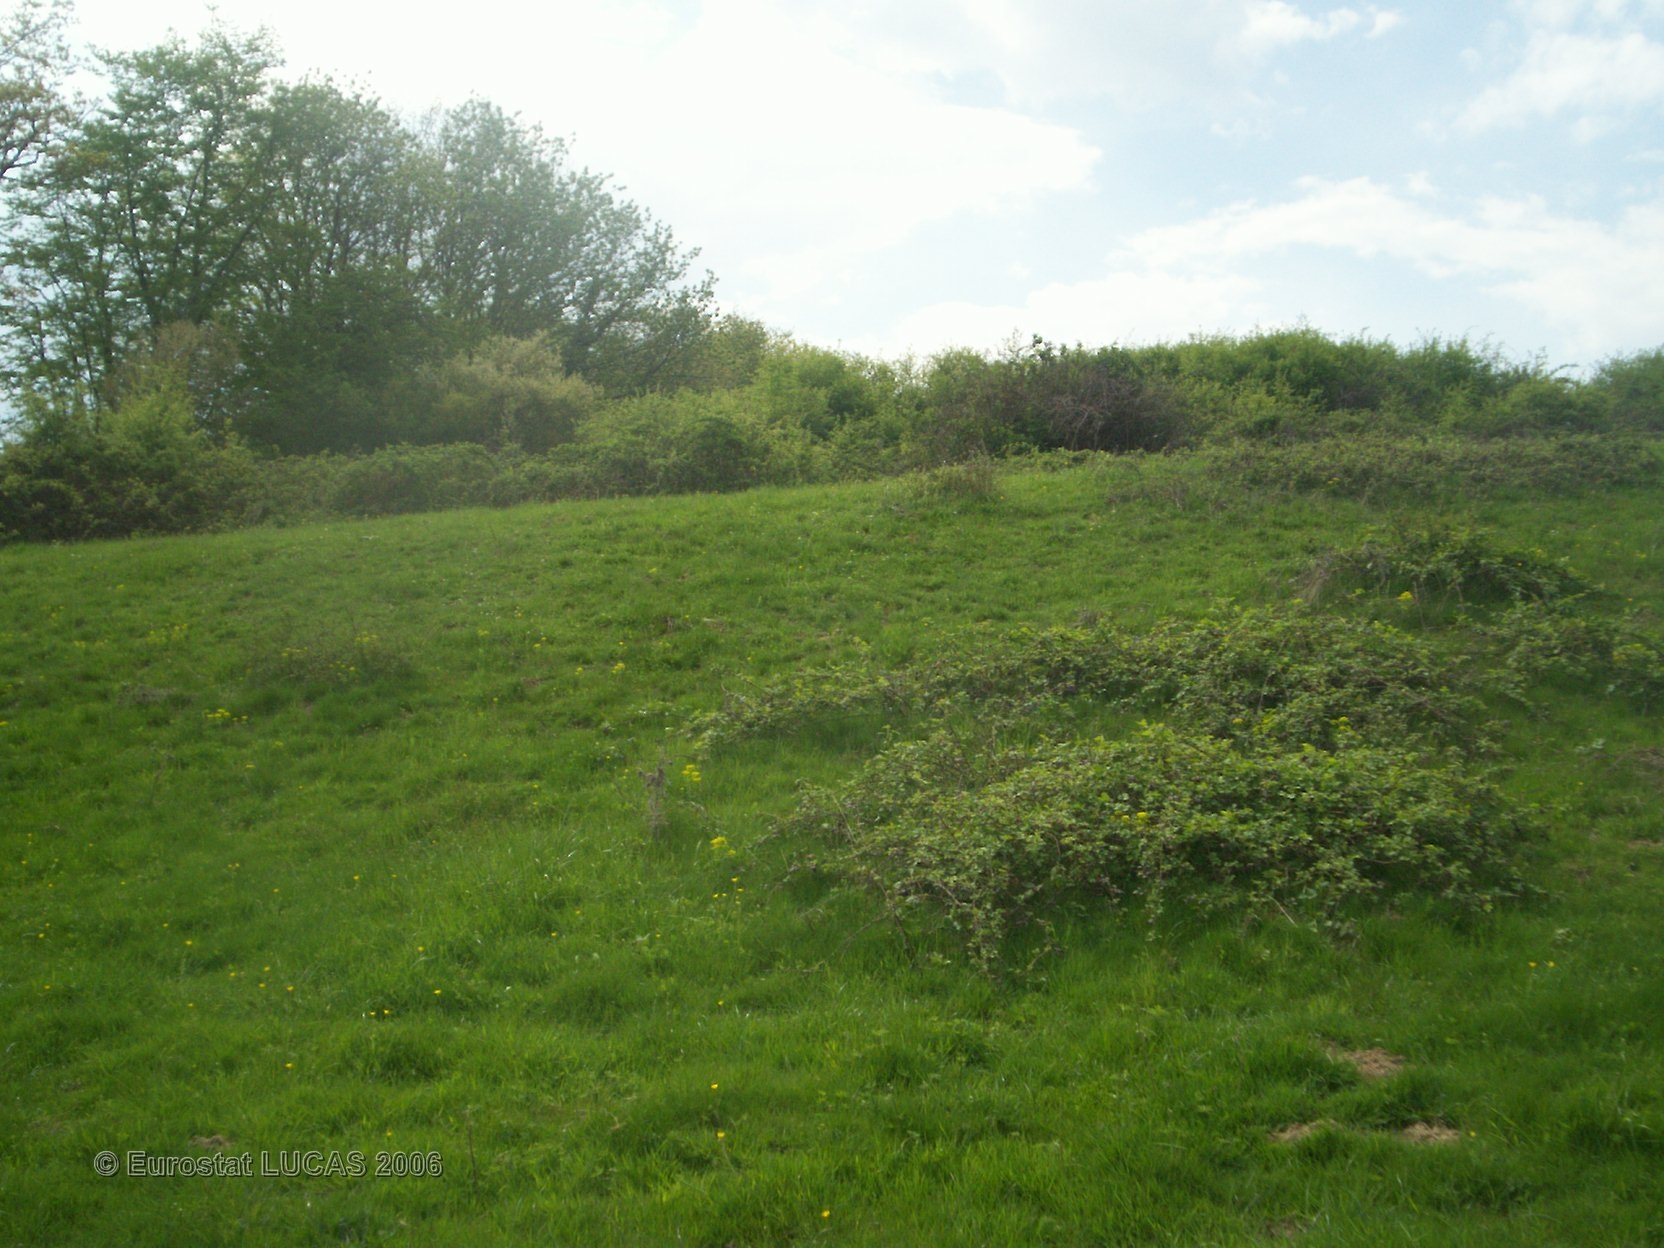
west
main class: Grassland
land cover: Grassland without tree/shrub cover
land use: Agriculture (excluding fallow land and kitchen gardens)
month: May
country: FR
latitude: 46.4022
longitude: 3.1433
